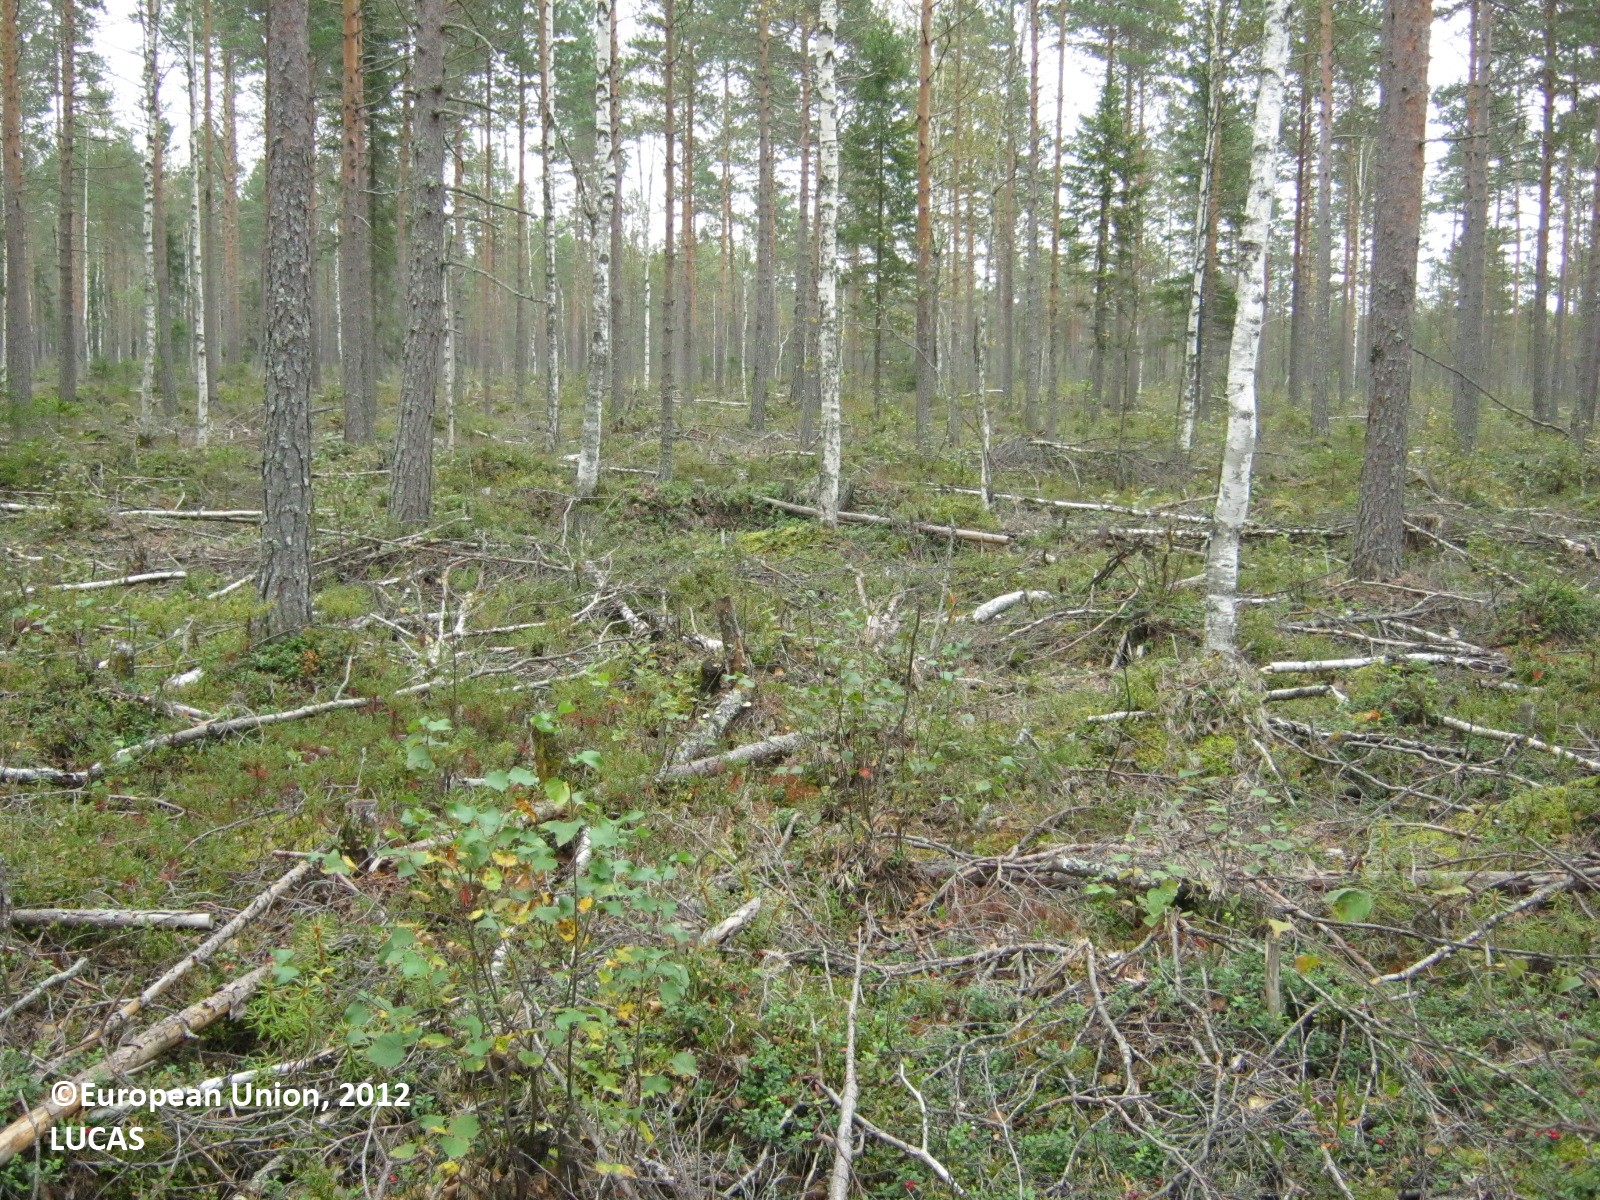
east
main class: Woodland
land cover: Pine dominated mixed woodland
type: boreal forest
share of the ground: 50 - 75 %
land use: Forestry
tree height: > 5 m
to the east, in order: Pine dominated mixed woodland; Ditches and canals; Pine dominated mixed woodland; Ditches and canals; Pine dominated mixed woodland; Ditches and canals; Pine dominated mixed woodland; Ditches and canals; Pine dominated mixed woodland; Ditches and canals; Pine dominated mixed woodland; Ditches and canals; Pine dominated mixed woodland
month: September
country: FI
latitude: 60.9965
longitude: 27.9656
